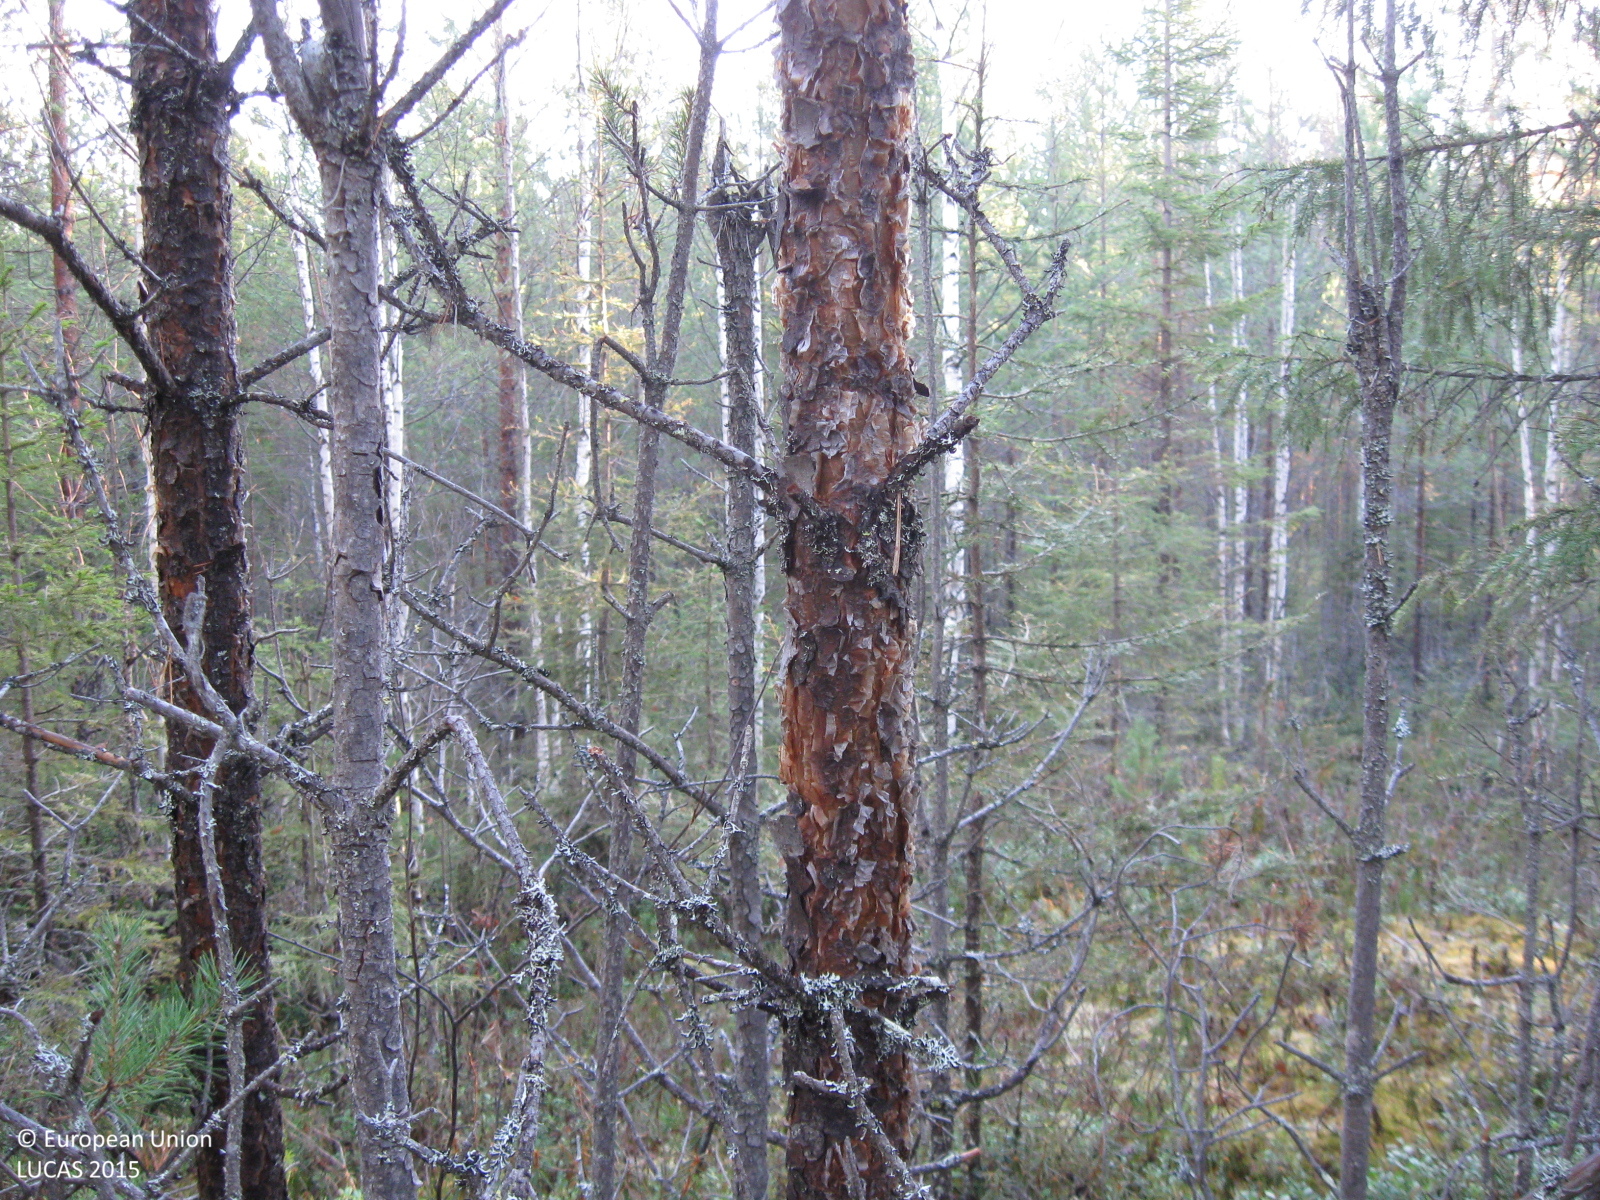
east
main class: Woodland
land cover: Pine dominated coniferous woodland
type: boreal forest
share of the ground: > 75 %
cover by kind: coniferous forest trees 80 %, broadleaved forest trees 5 %, shrubs 5 %, herbaceous plants 5 %, lichens and mosses 5 %
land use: Forestry
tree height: > 5 m
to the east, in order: Pine dominated coniferous woodland; Pine dominated mixed woodland; Pine dominated coniferous woodland; Tracks; Pine dominated coniferous woodland; Ditches and canals; Pine dominated coniferous woodland
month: November
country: SE
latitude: 66.1640
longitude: 20.8503
